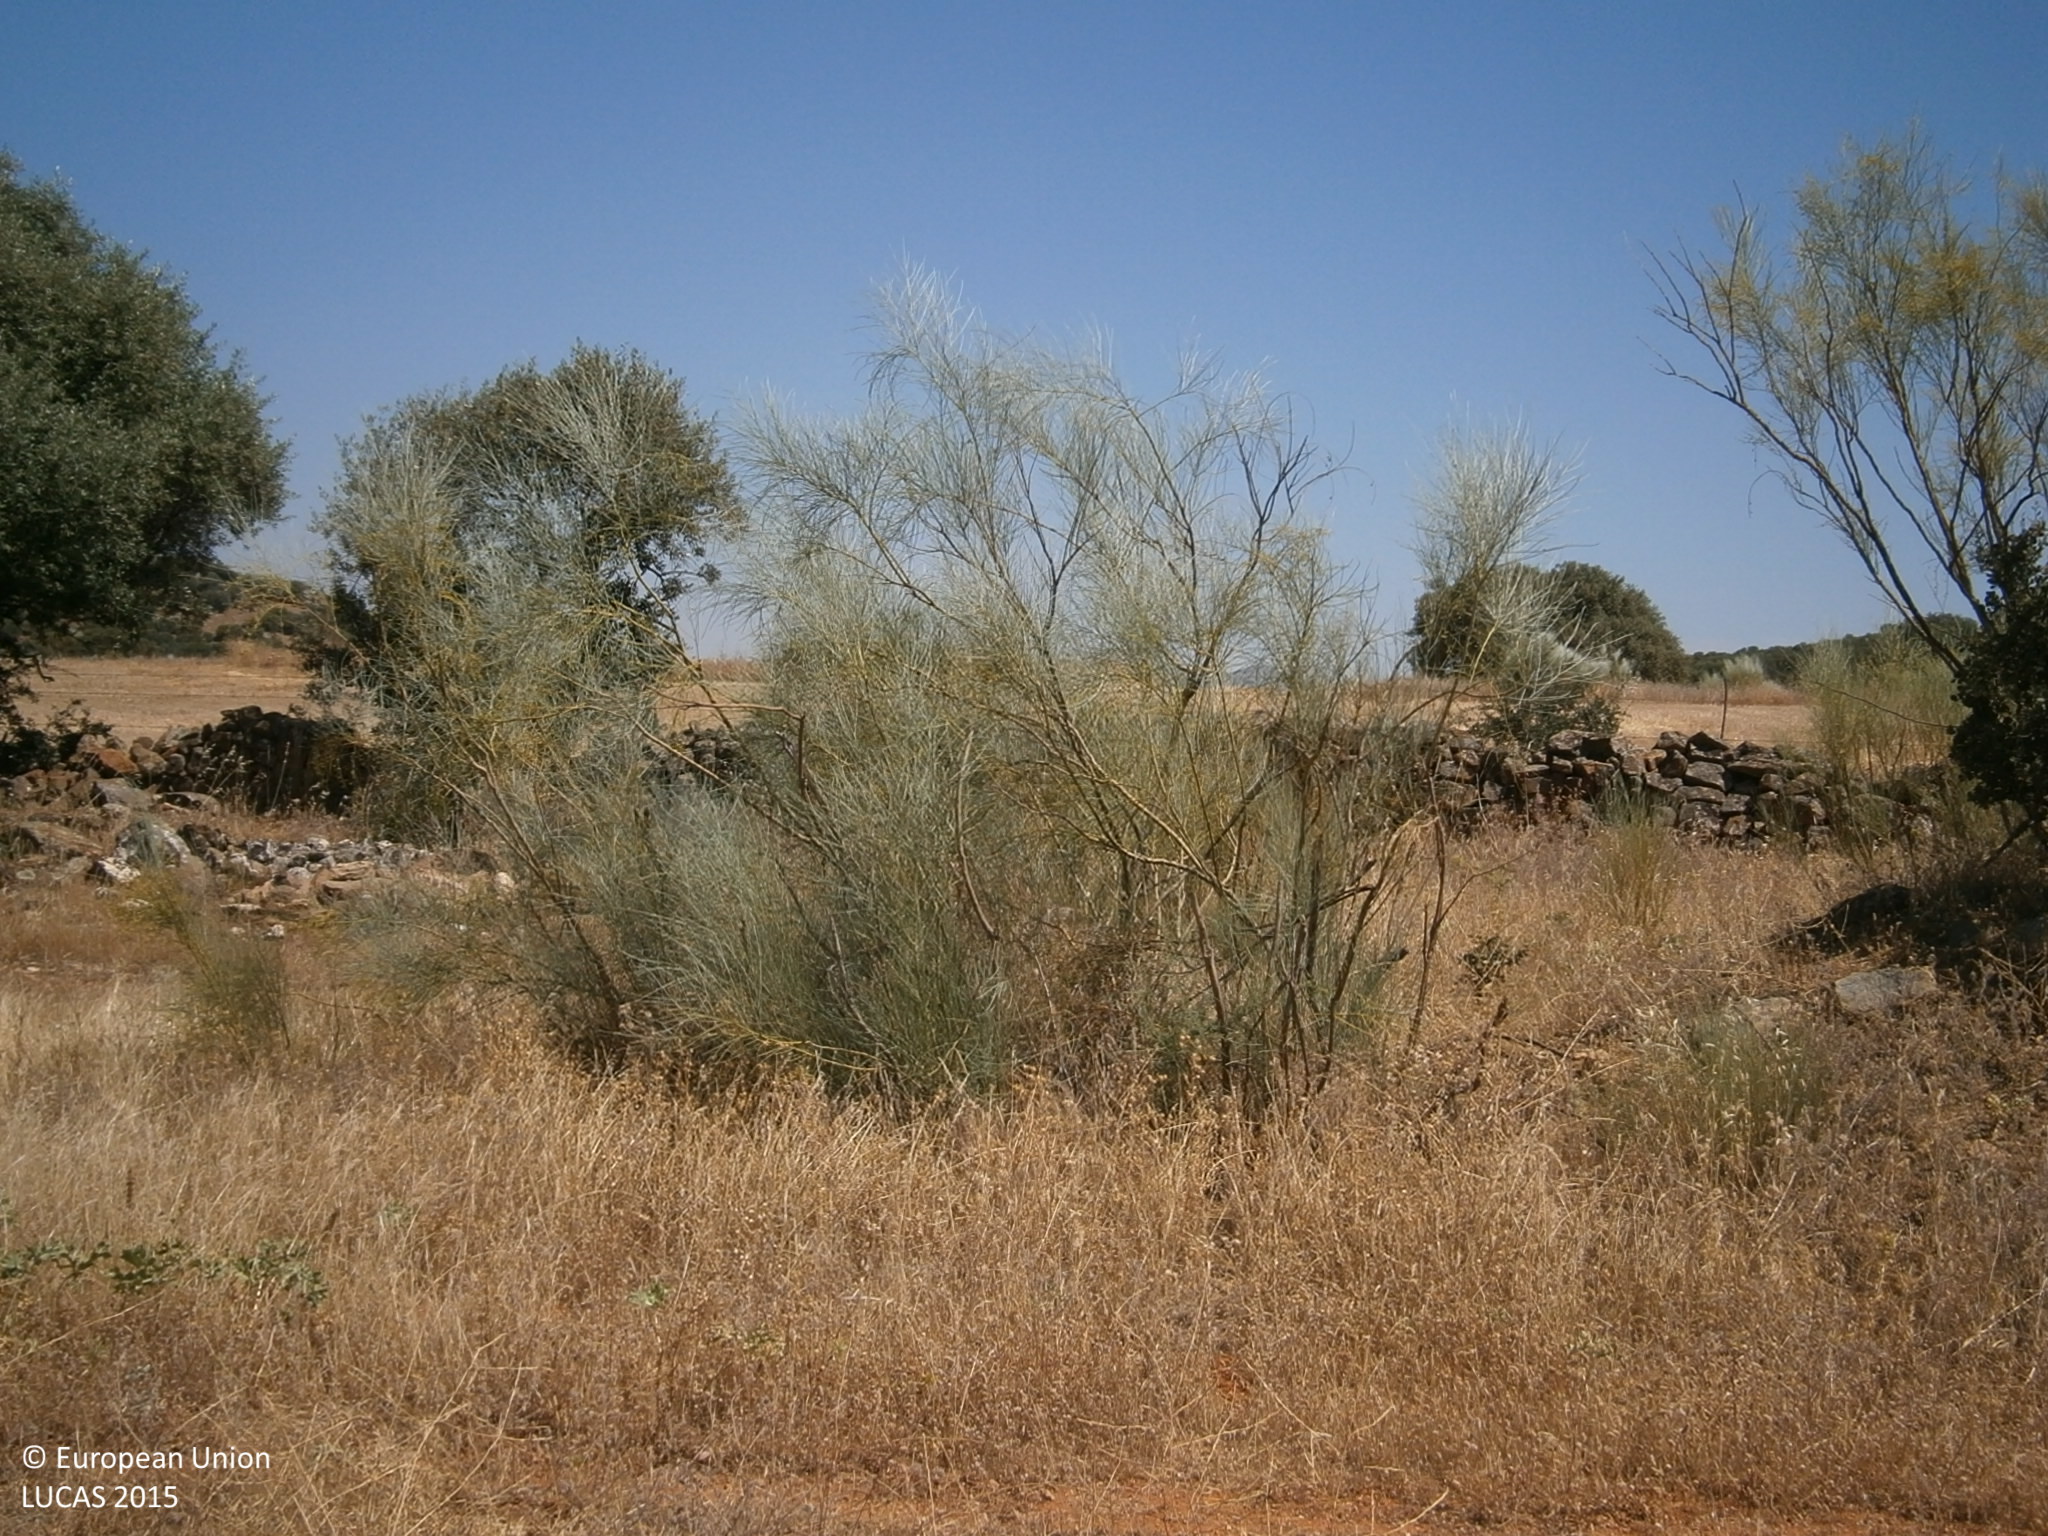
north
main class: Cropland
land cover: Durum wheat
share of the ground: > 75 %
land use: Agriculture (excluding fallow land and kitchen gardens)
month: June
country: ES
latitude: 38.6892
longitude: -6.2037
